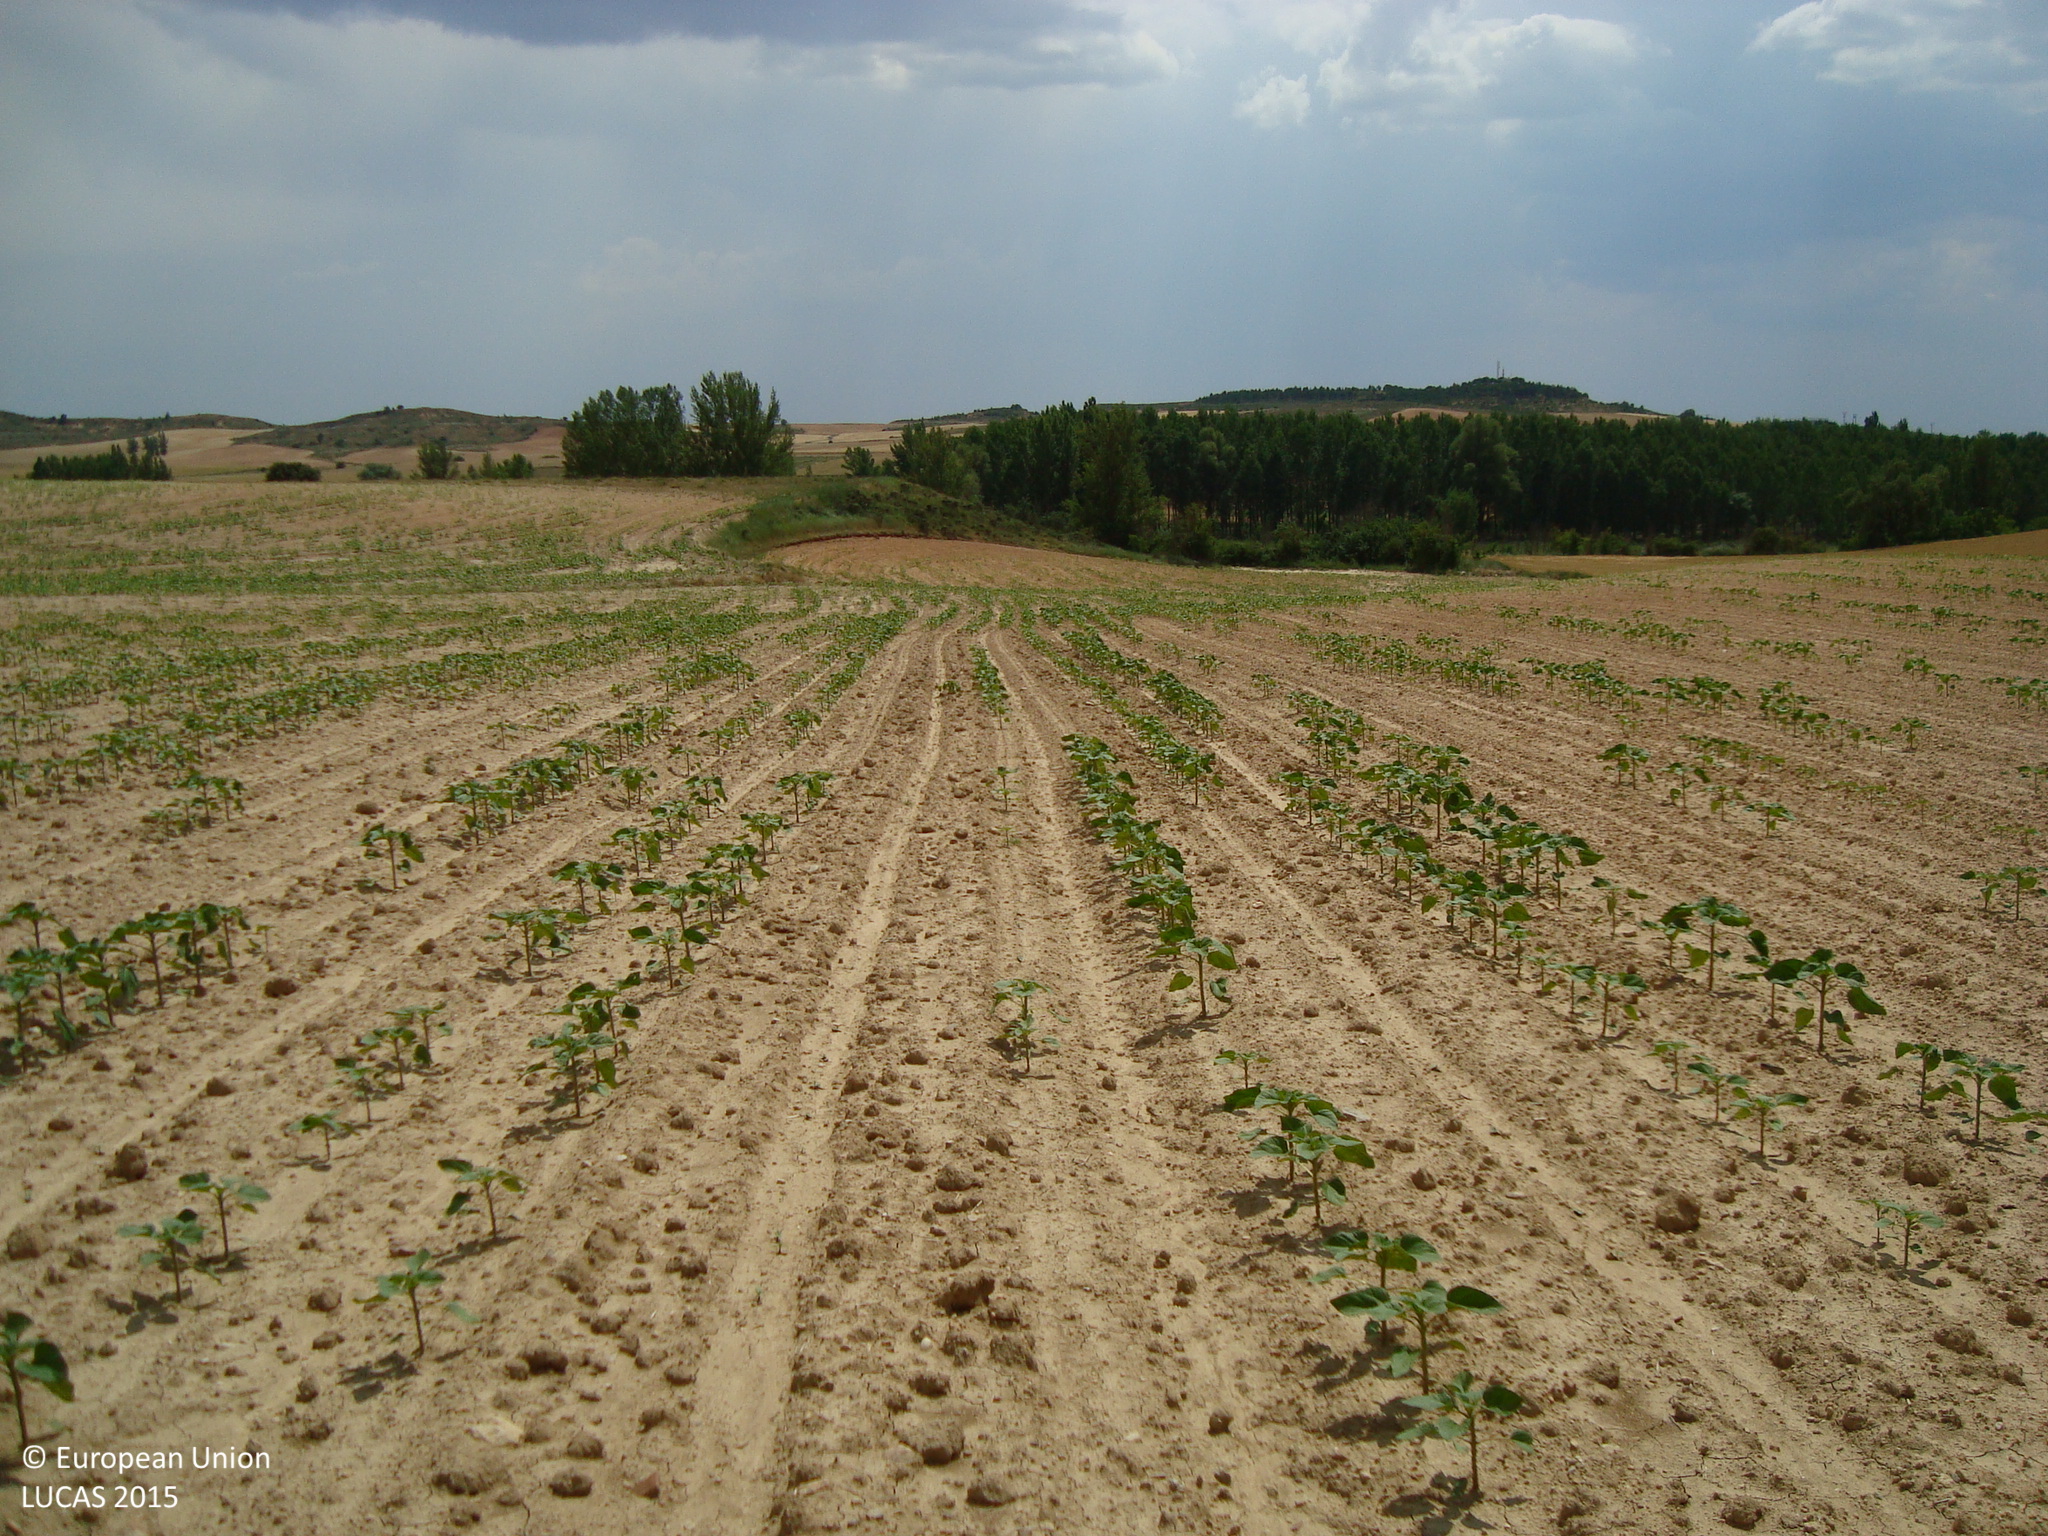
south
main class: Cropland
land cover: Sunflower
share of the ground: < 10 %
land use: Agriculture (excluding fallow land and kitchen gardens)
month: June
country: ES
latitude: 41.8769
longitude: -3.6098
